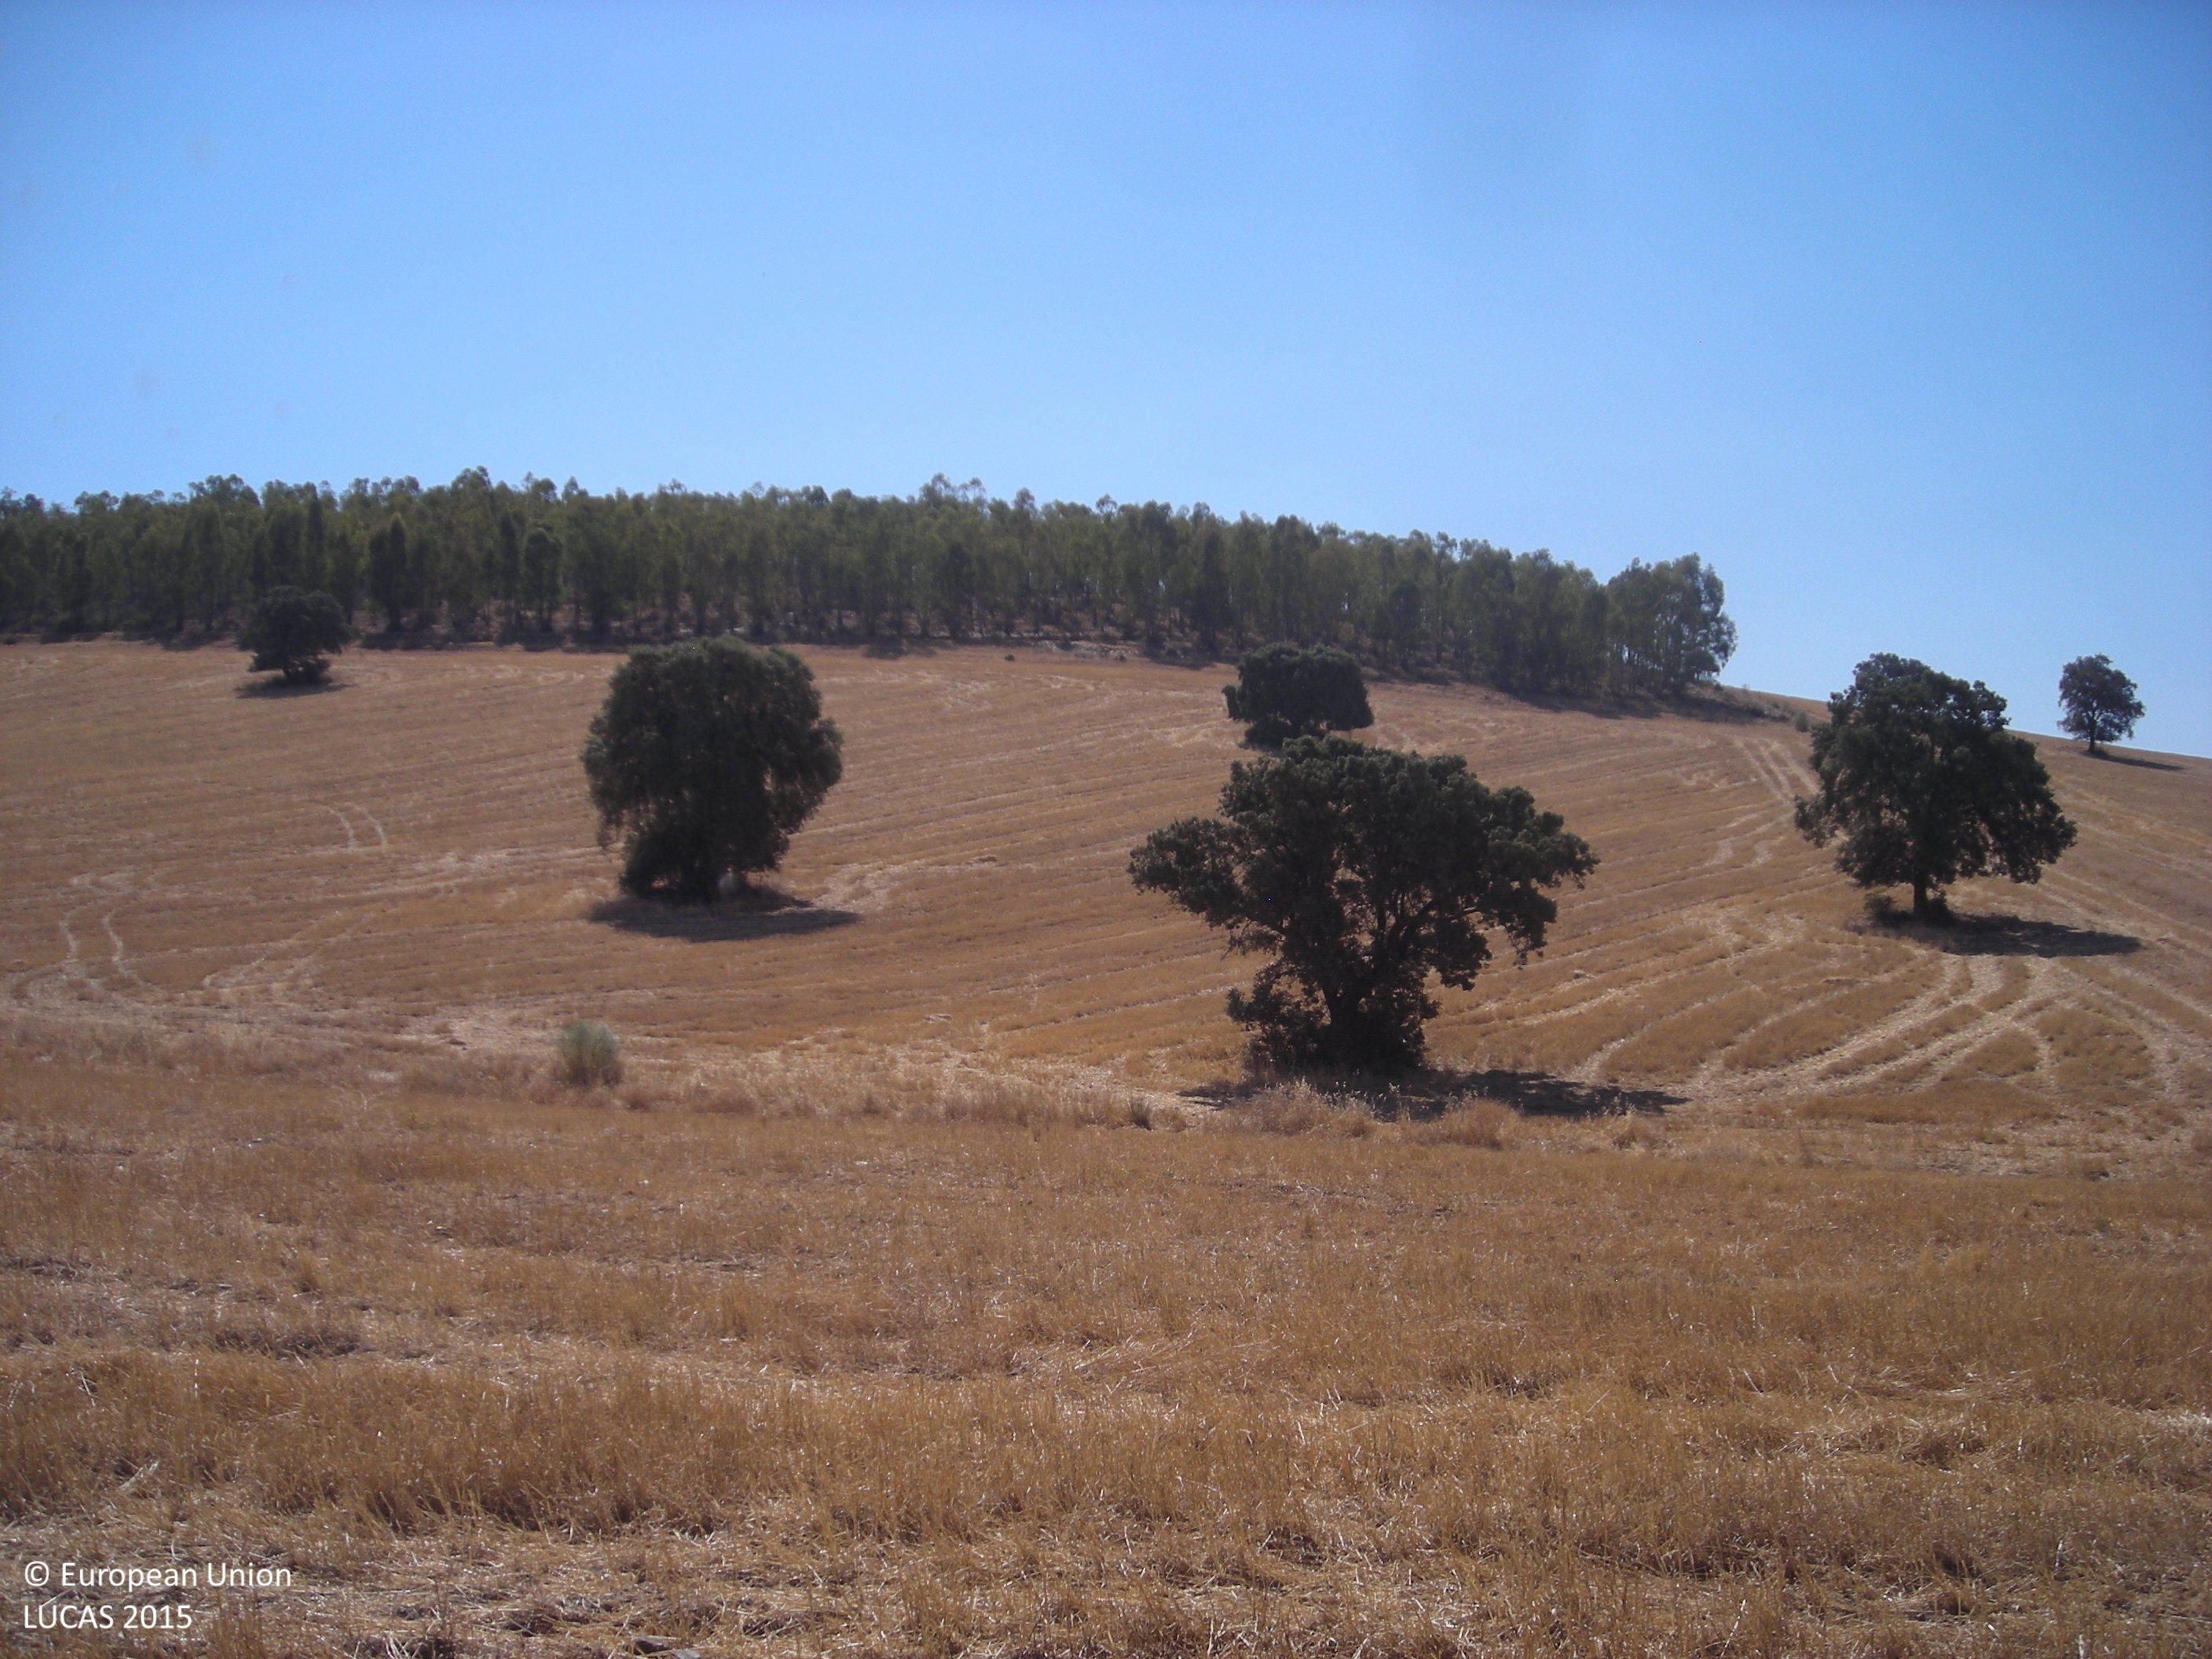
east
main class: Woodland
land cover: Broadleaved woodland
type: broadleaved evergreen forest
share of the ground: > 75 %
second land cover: Grassland without tree/shrub cover
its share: 10 - 25 %
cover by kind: broadleaved forest trees 85 %, herbaceous plants 15 %
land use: Forestry
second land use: Agriculture (excluding fallow land and kitchen gardens)
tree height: > 5 m
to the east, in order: Broadleaved woodland; Grassland without tree/shrub cover
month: July
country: ES
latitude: 38.8523
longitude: -5.8919
